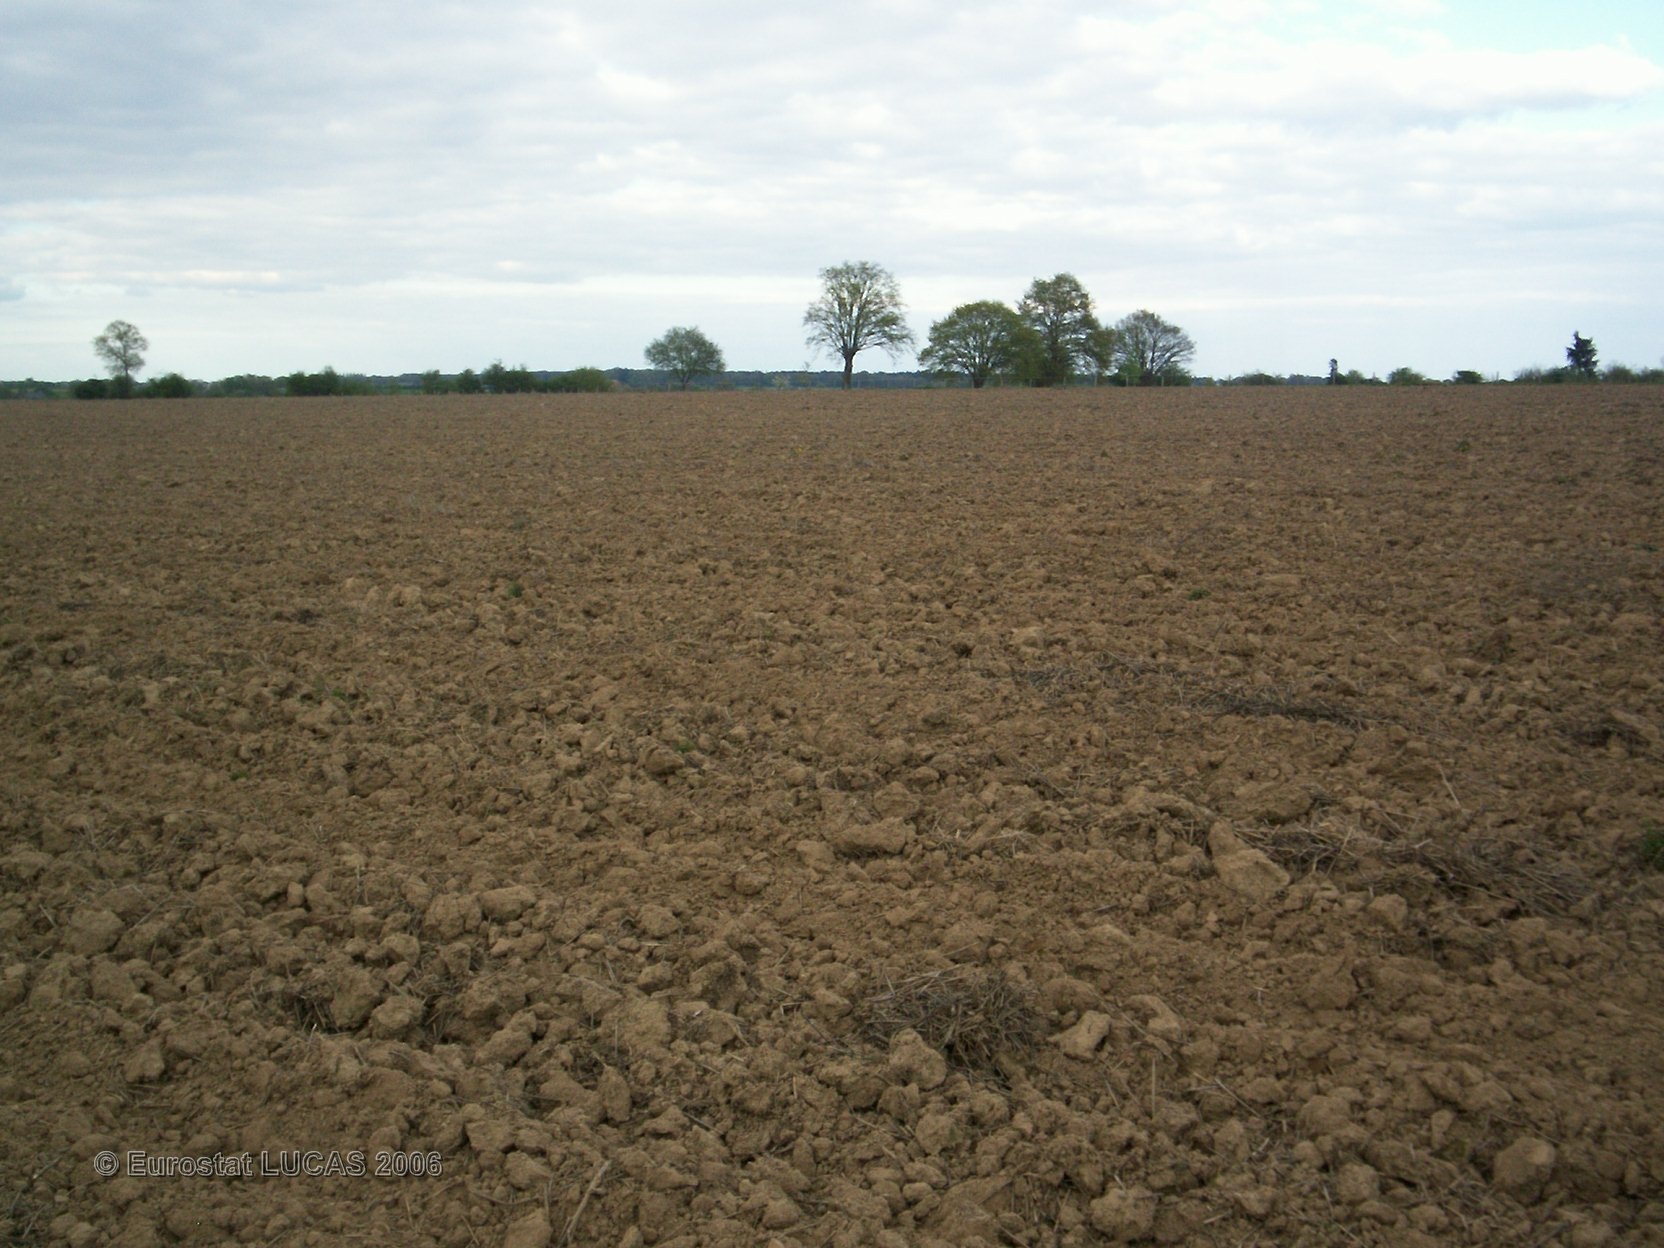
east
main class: Cropland
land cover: Maize
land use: Agriculture (excluding fallow land and kitchen gardens)
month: May
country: FR
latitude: 48.0206
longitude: -0.2067
